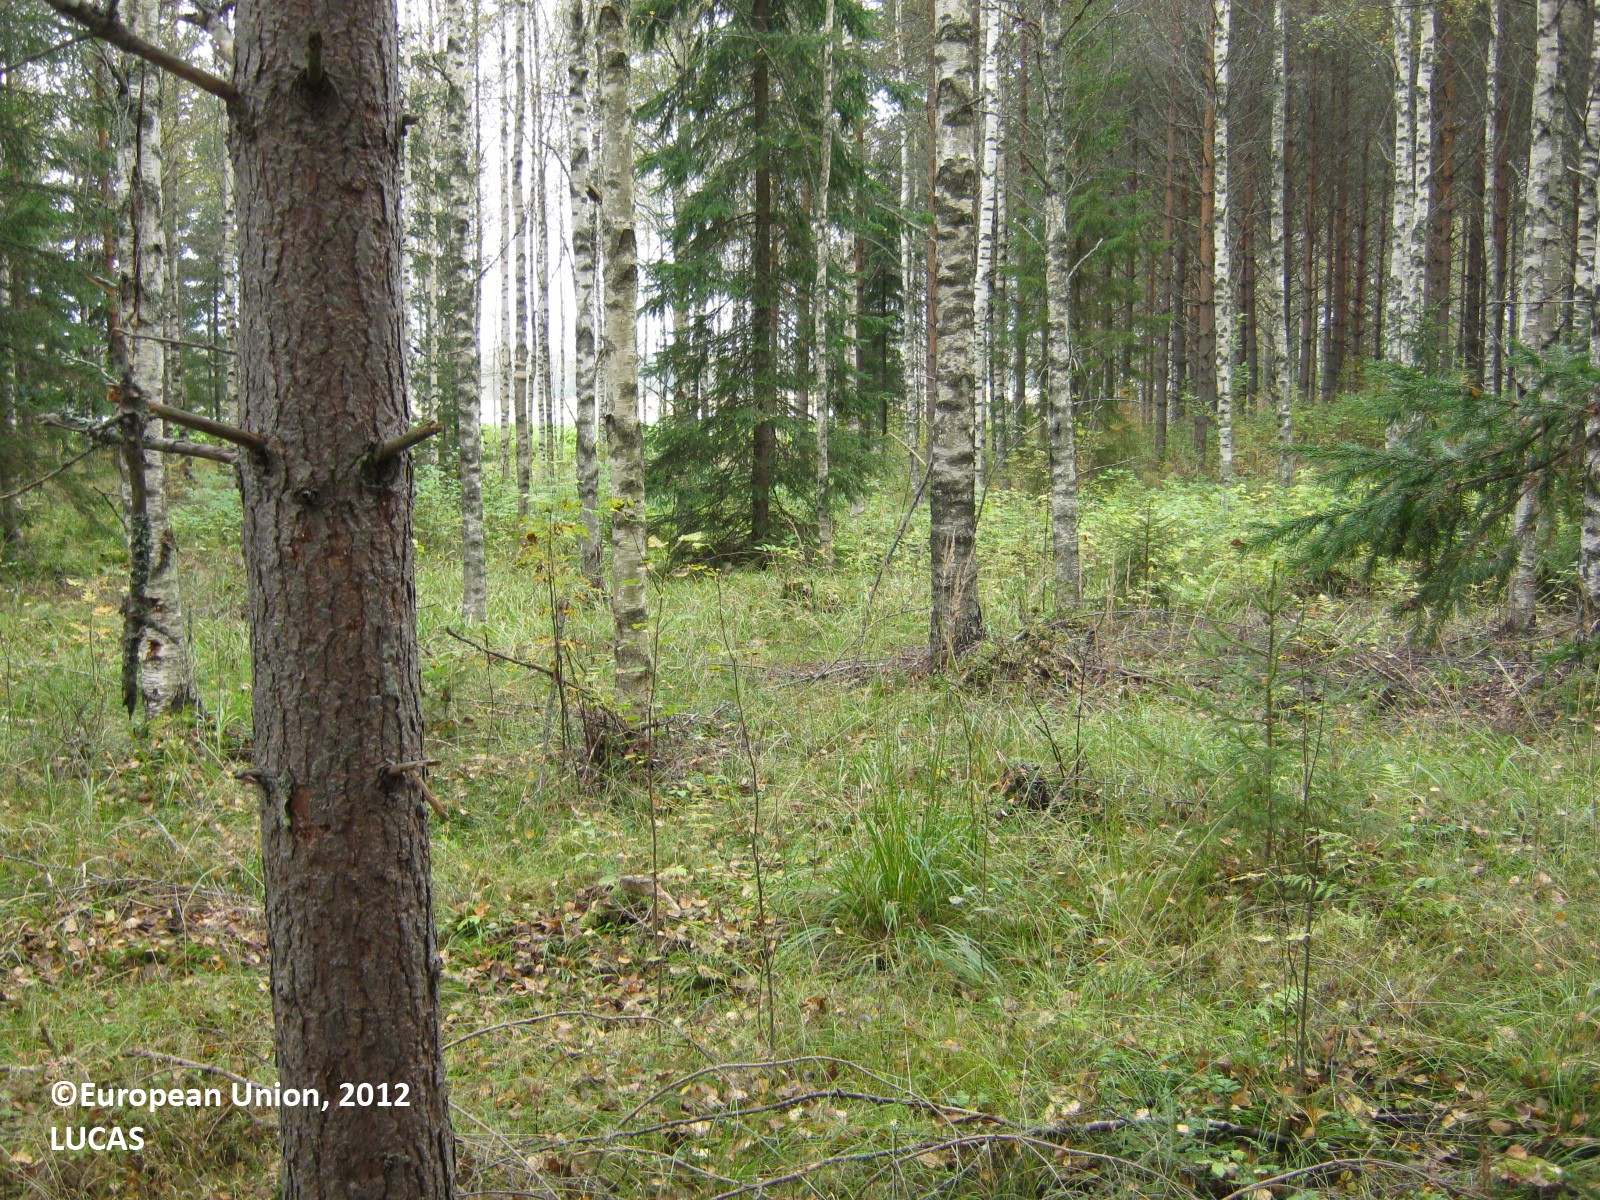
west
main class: Woodland
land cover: Other mixed woodland
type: boreal forest
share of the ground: > 75 %
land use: Forestry
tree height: > 5 m
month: September
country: FI
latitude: 61.0047
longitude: 28.0468
